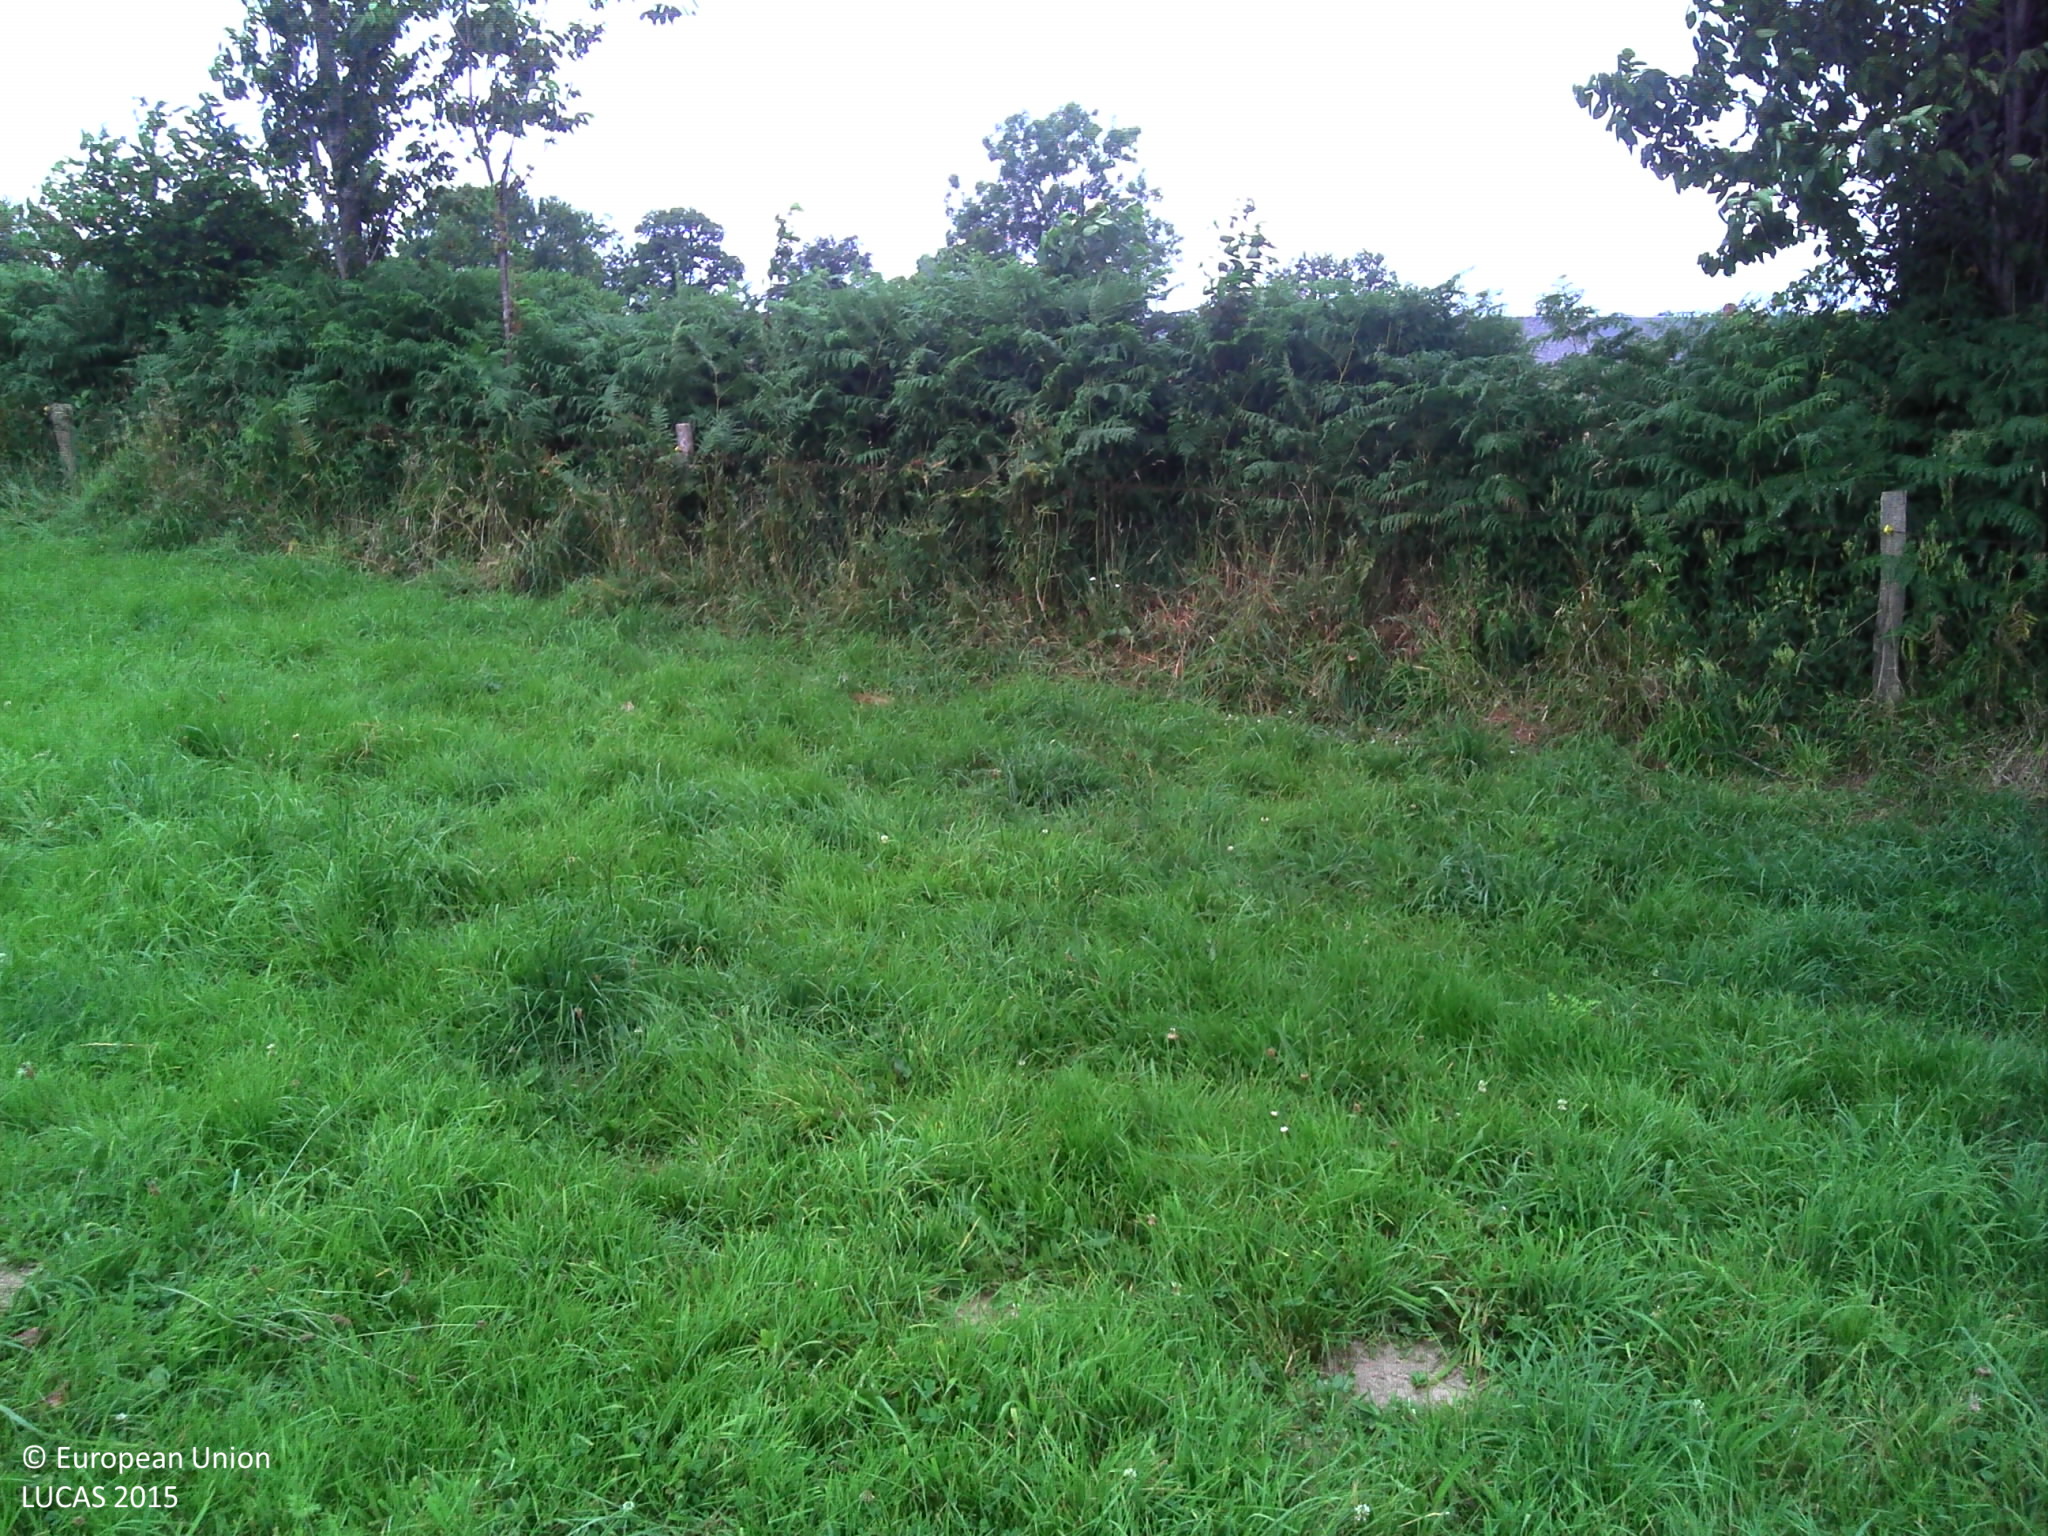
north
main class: Grassland
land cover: Grassland without tree/shrub cover
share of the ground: > 75 %
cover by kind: herbaceous plants 100 %
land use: Agriculture (excluding fallow land and kitchen gardens)
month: July
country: FR
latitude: 48.8298
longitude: -1.3940
